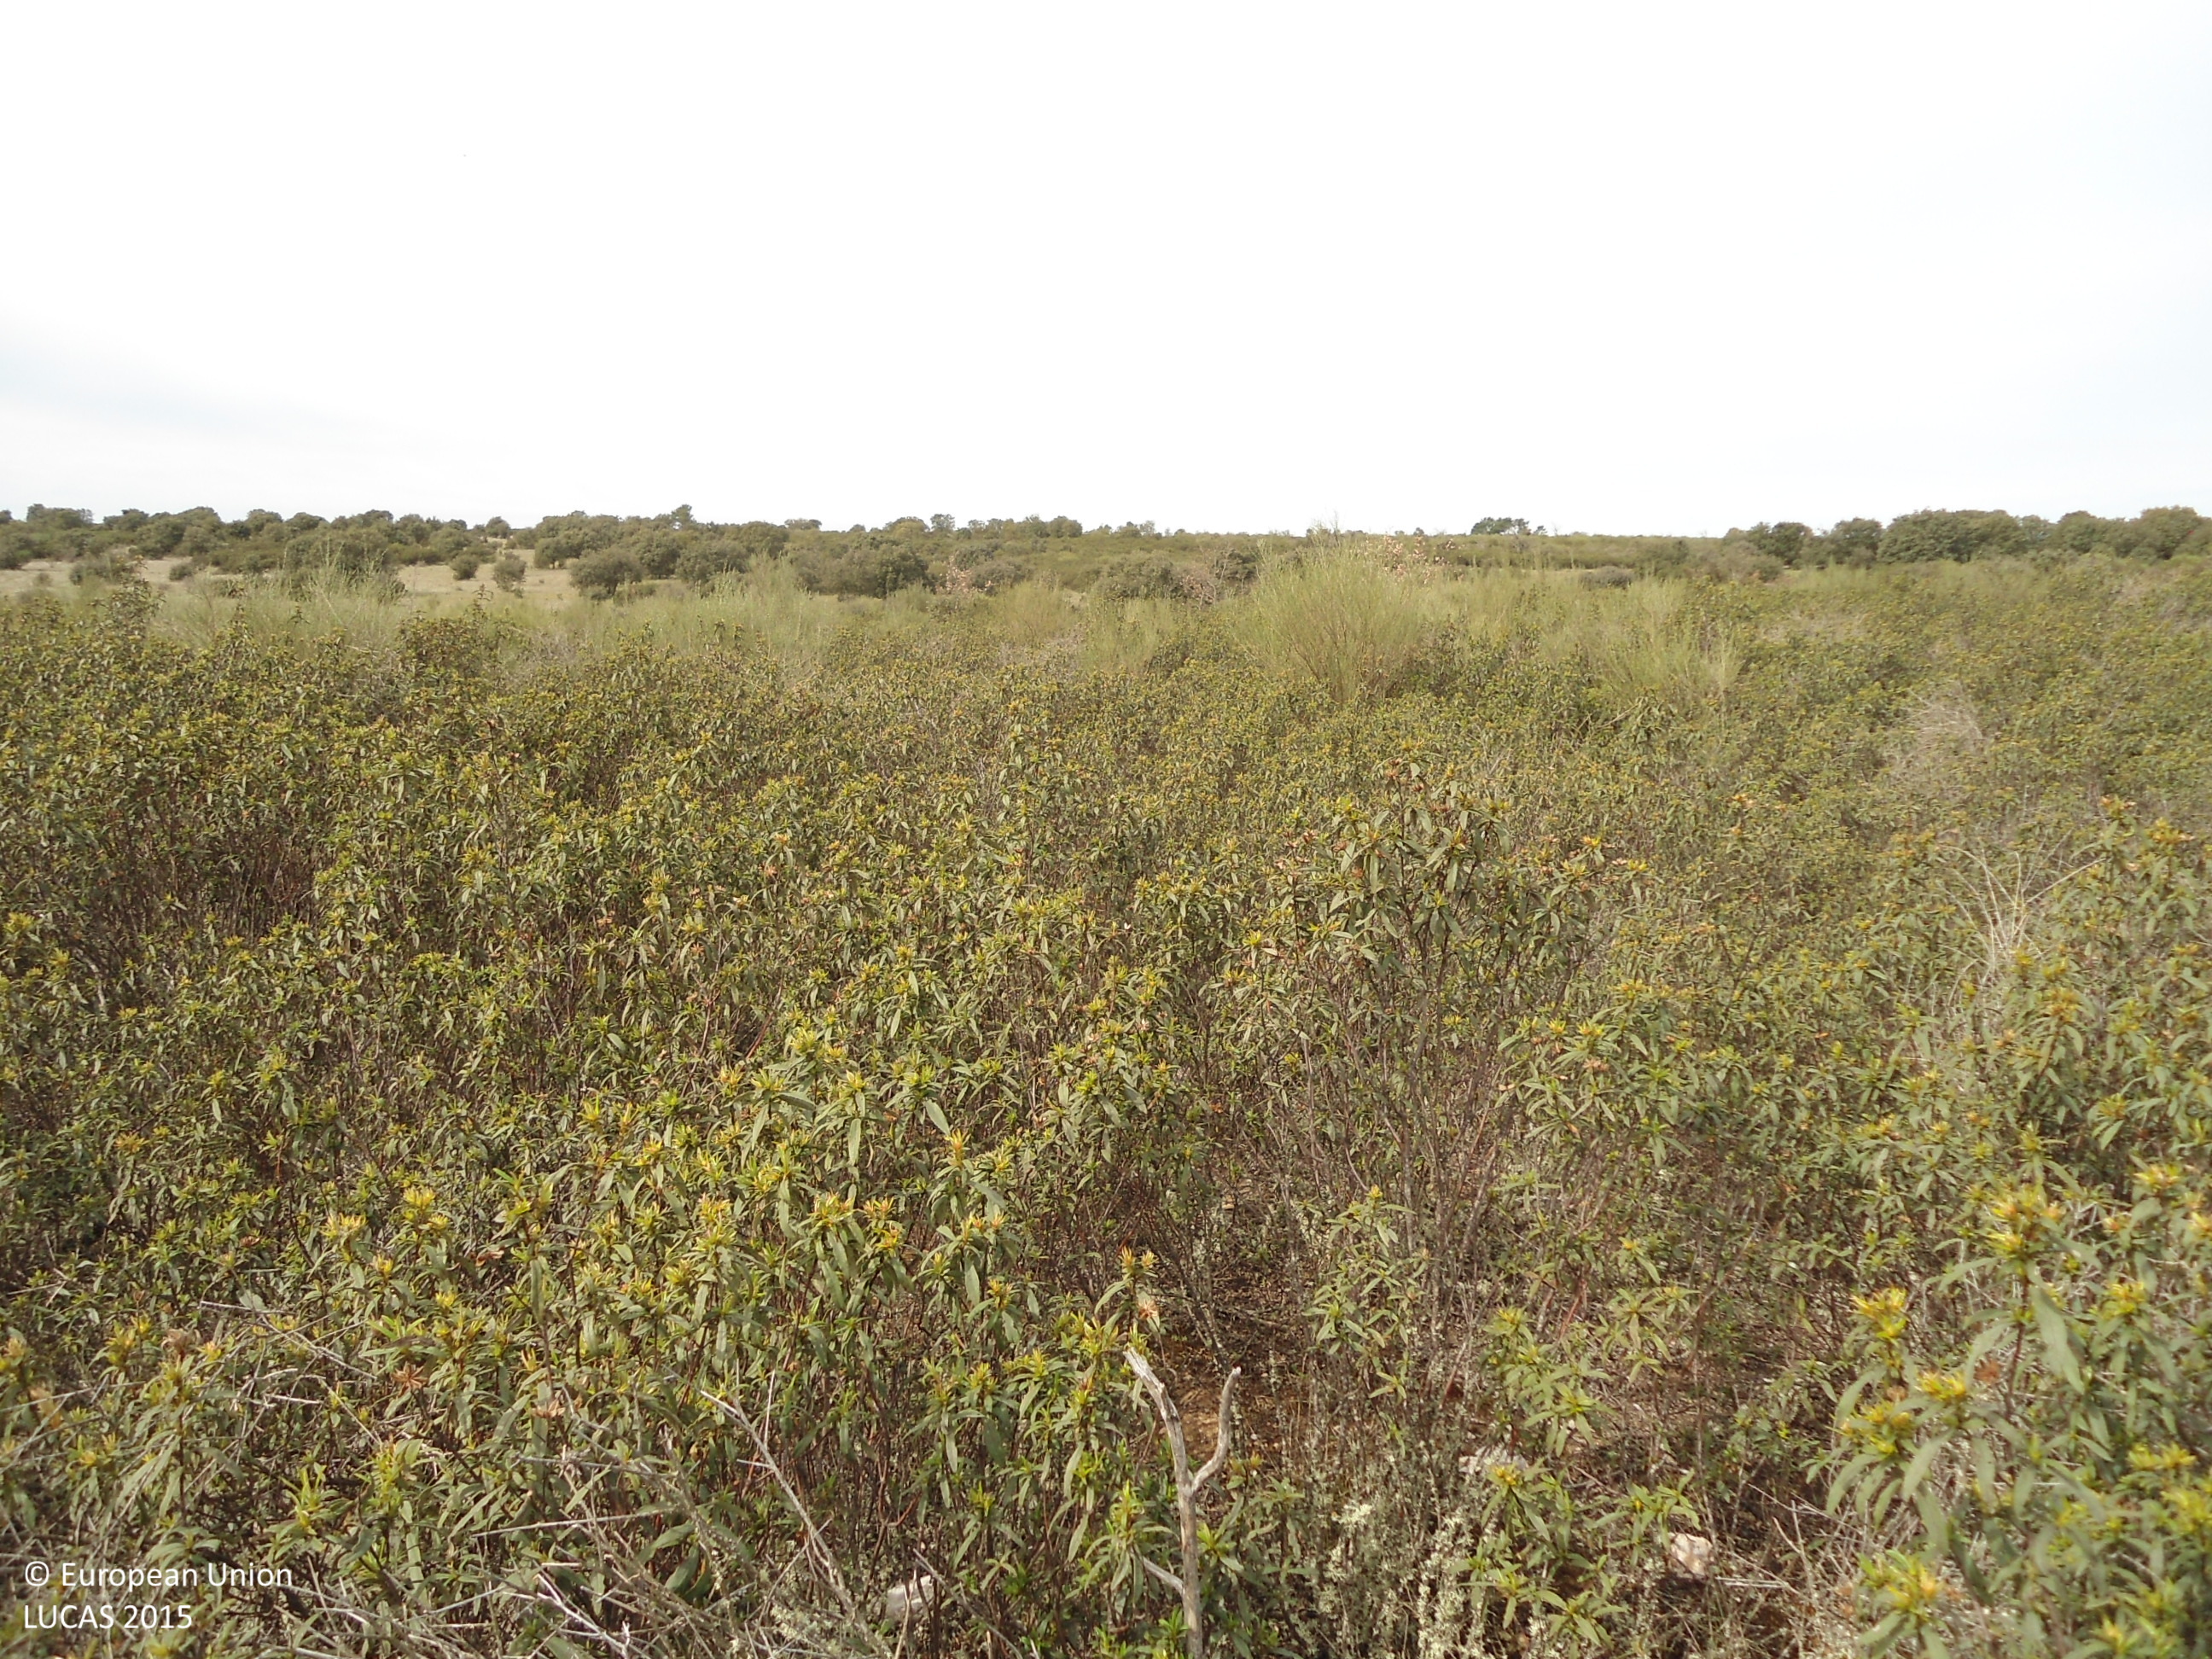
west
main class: Shrubland
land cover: Shrubland with sparse tree cover
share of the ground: > 75 %
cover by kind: shrubs 95 %, broadleaved forest trees 5 %
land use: Semi-natural and natural areas not in use
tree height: < 5 m
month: April
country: ES
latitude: 41.6285
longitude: -6.1204
